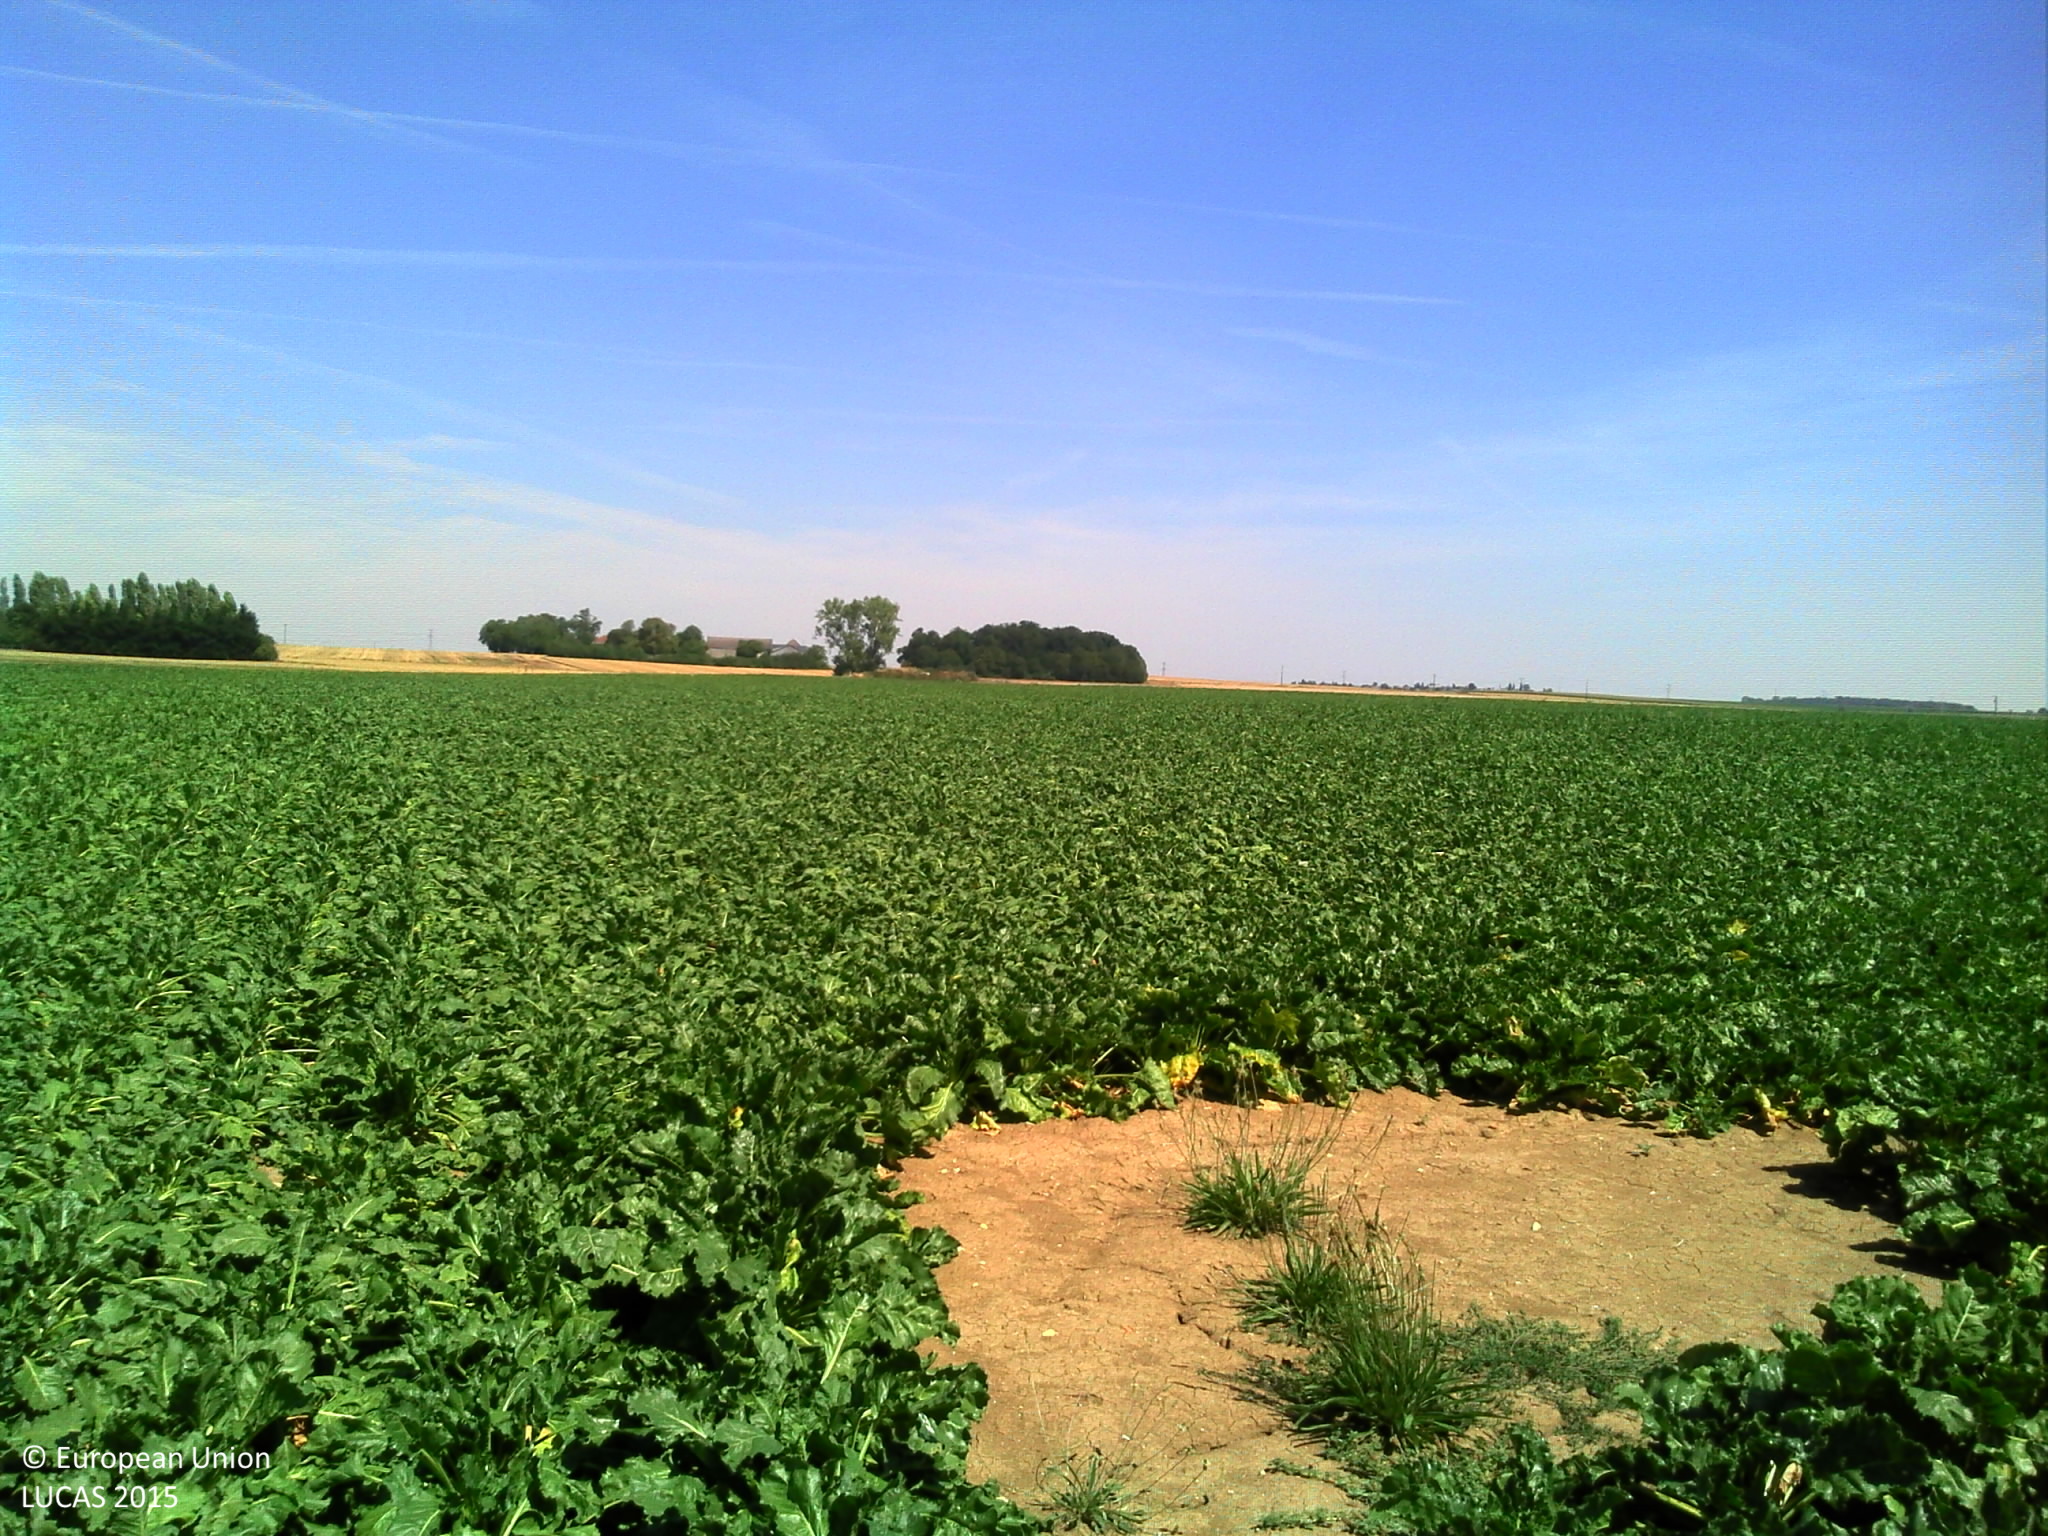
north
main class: Cropland
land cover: Sugar beet
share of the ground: > 75 %
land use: Agriculture (excluding fallow land and kitchen gardens)
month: August
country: FR
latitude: 48.1091
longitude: 1.9420
